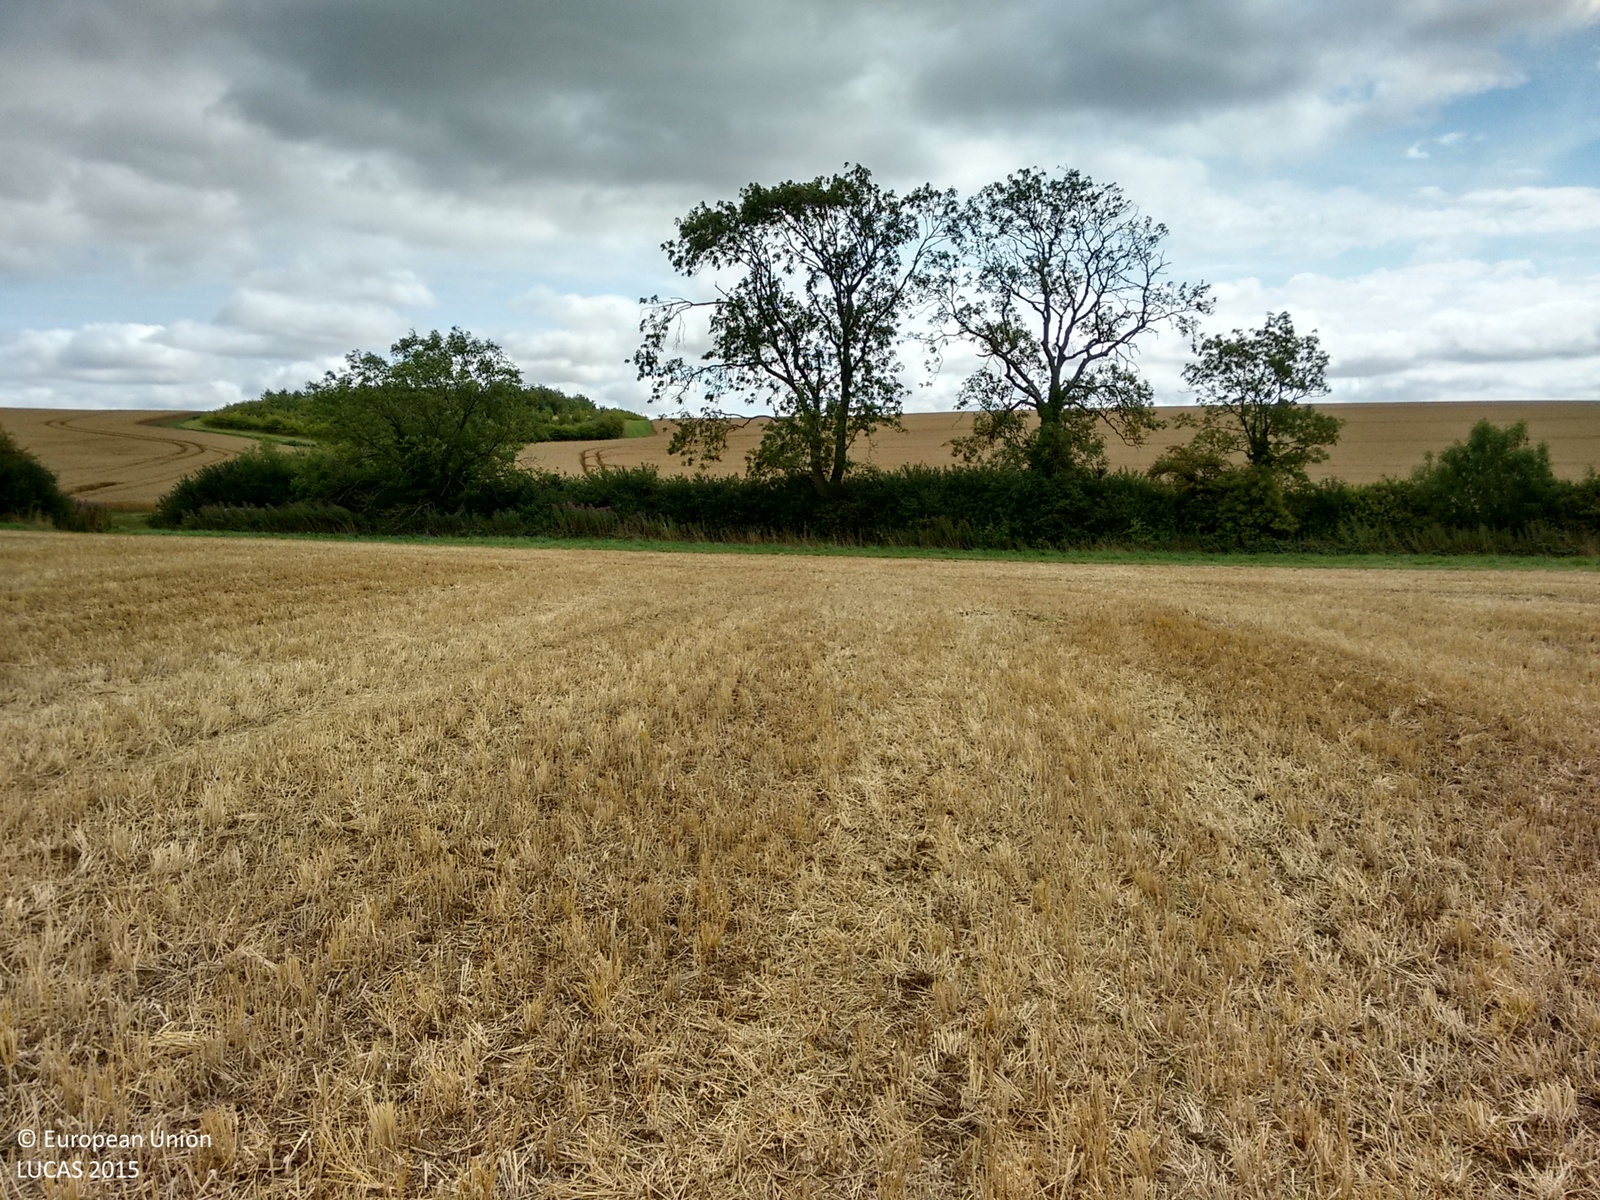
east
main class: Cropland
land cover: Common wheat
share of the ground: 10 - 25 %
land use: Agriculture (excluding fallow land and kitchen gardens)
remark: Harvested field
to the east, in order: Common wheat; Grass margins; Managed hedges; Grassland without tree/shrub cover; Common wheat; Grassland without tree/shrub cover; Managed hedges
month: August
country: GB
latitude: 52.3670
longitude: -0.8665
